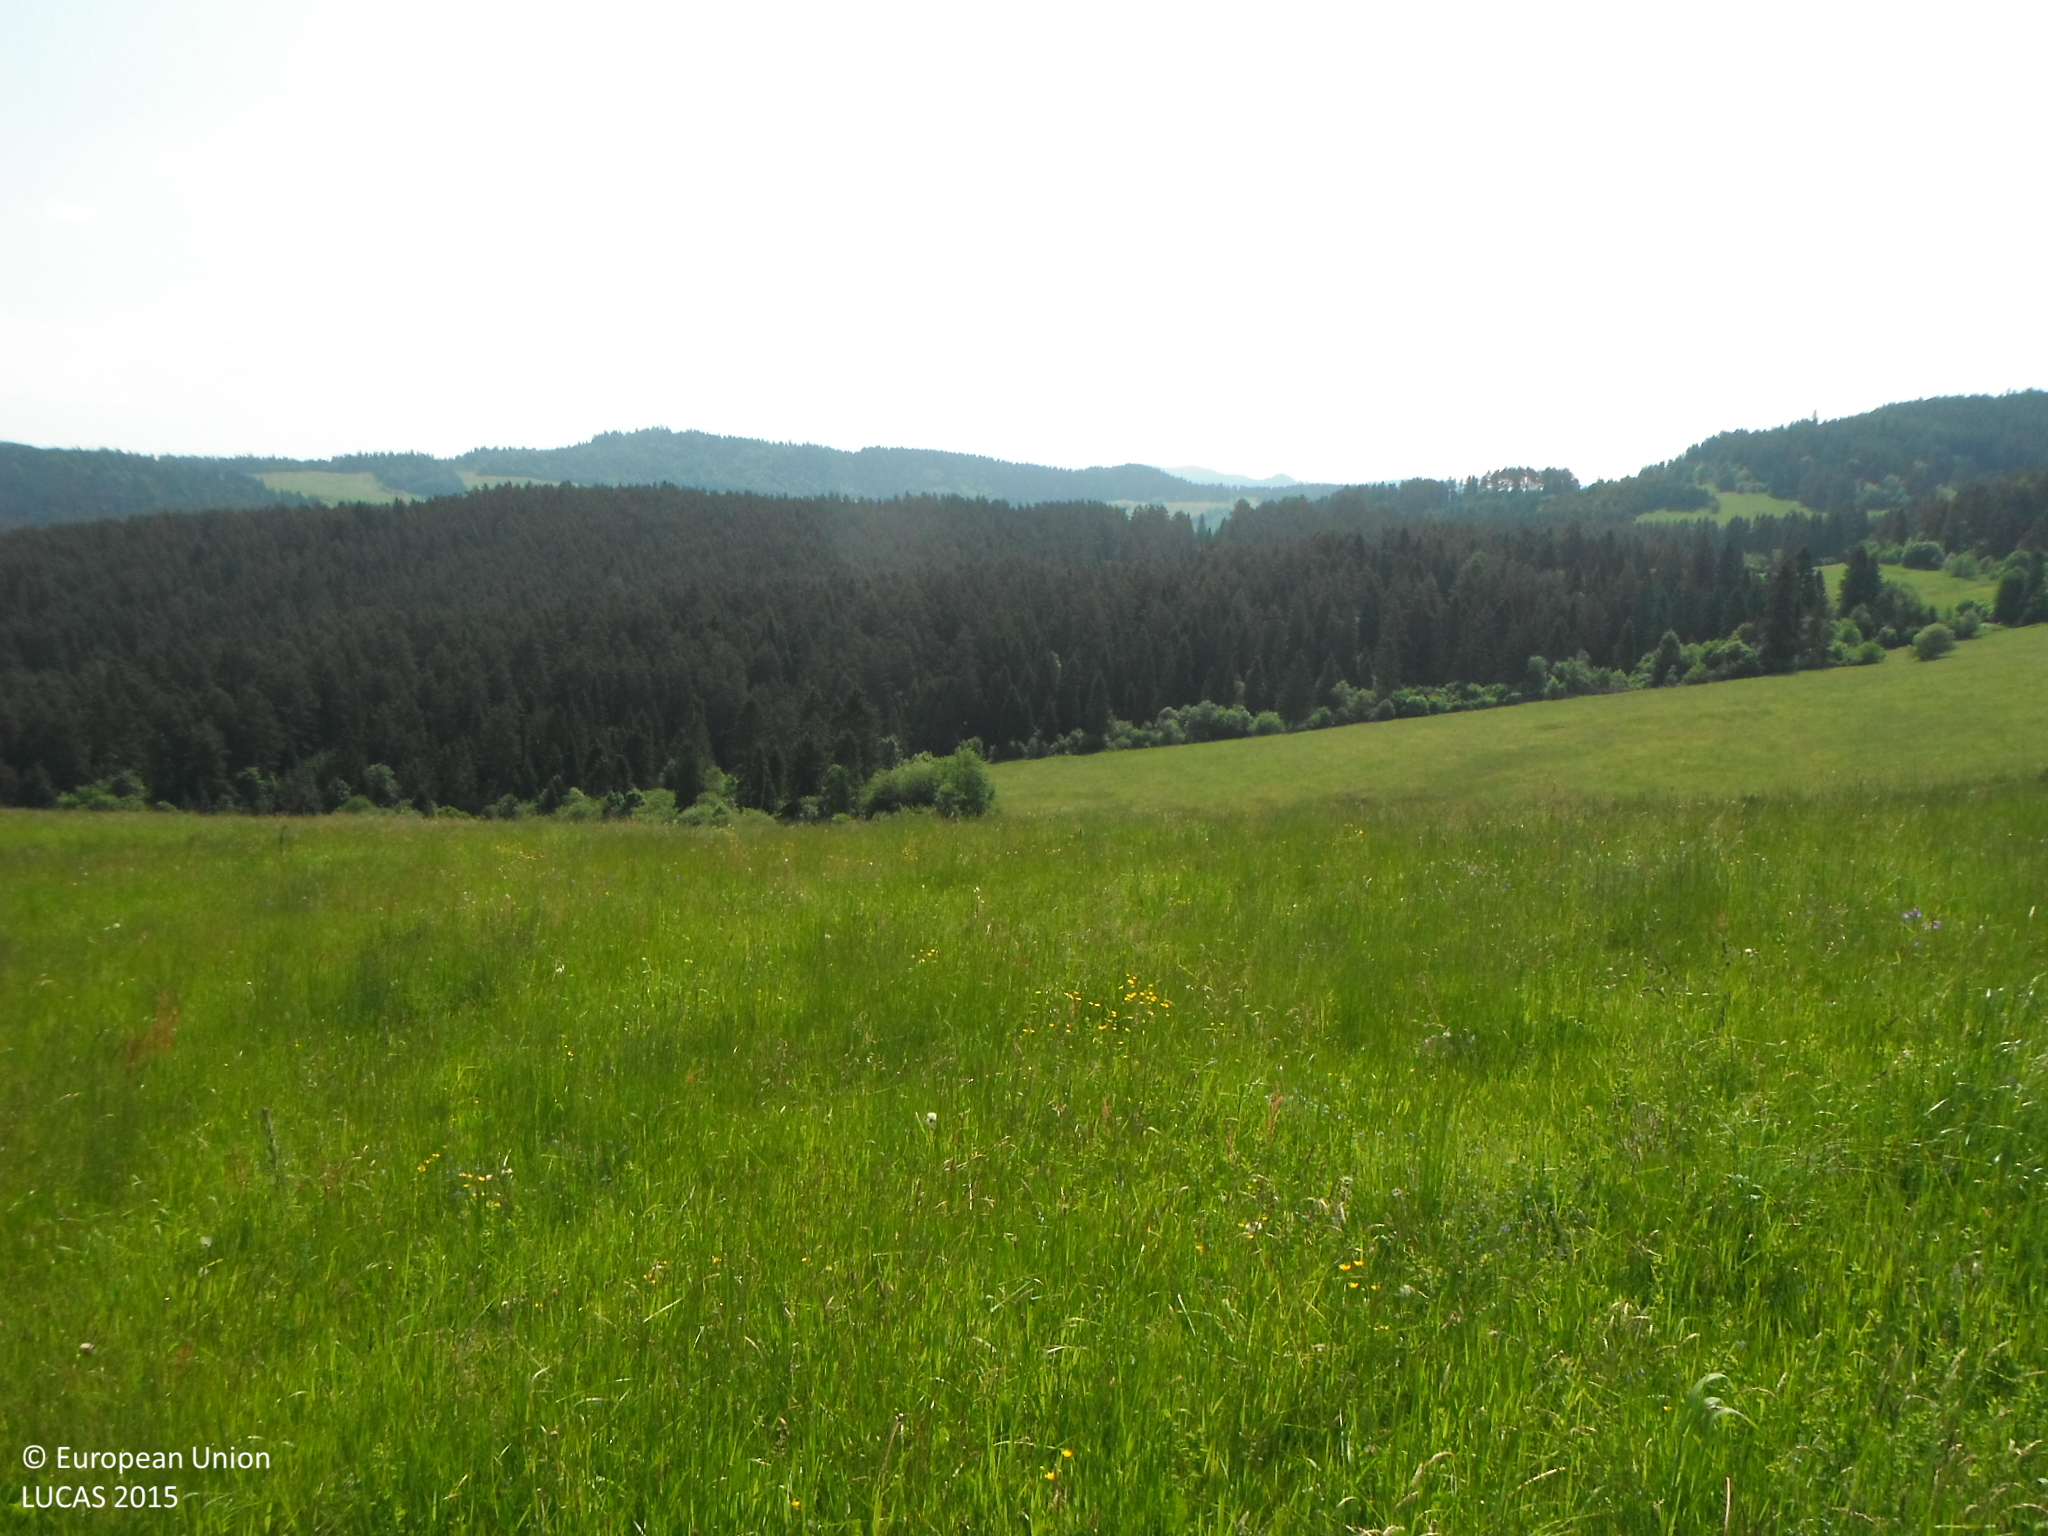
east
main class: Grassland
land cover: Grassland without tree/shrub cover
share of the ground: > 75 %
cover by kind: herbaceous plants 100 %
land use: Agriculture (excluding fallow land and kitchen gardens)
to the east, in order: Grassland without tree/shrub cover; Tracks; Grassland without tree/shrub cover; Other mixed woodland
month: June
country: SK
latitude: 49.3471
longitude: 20.3728
